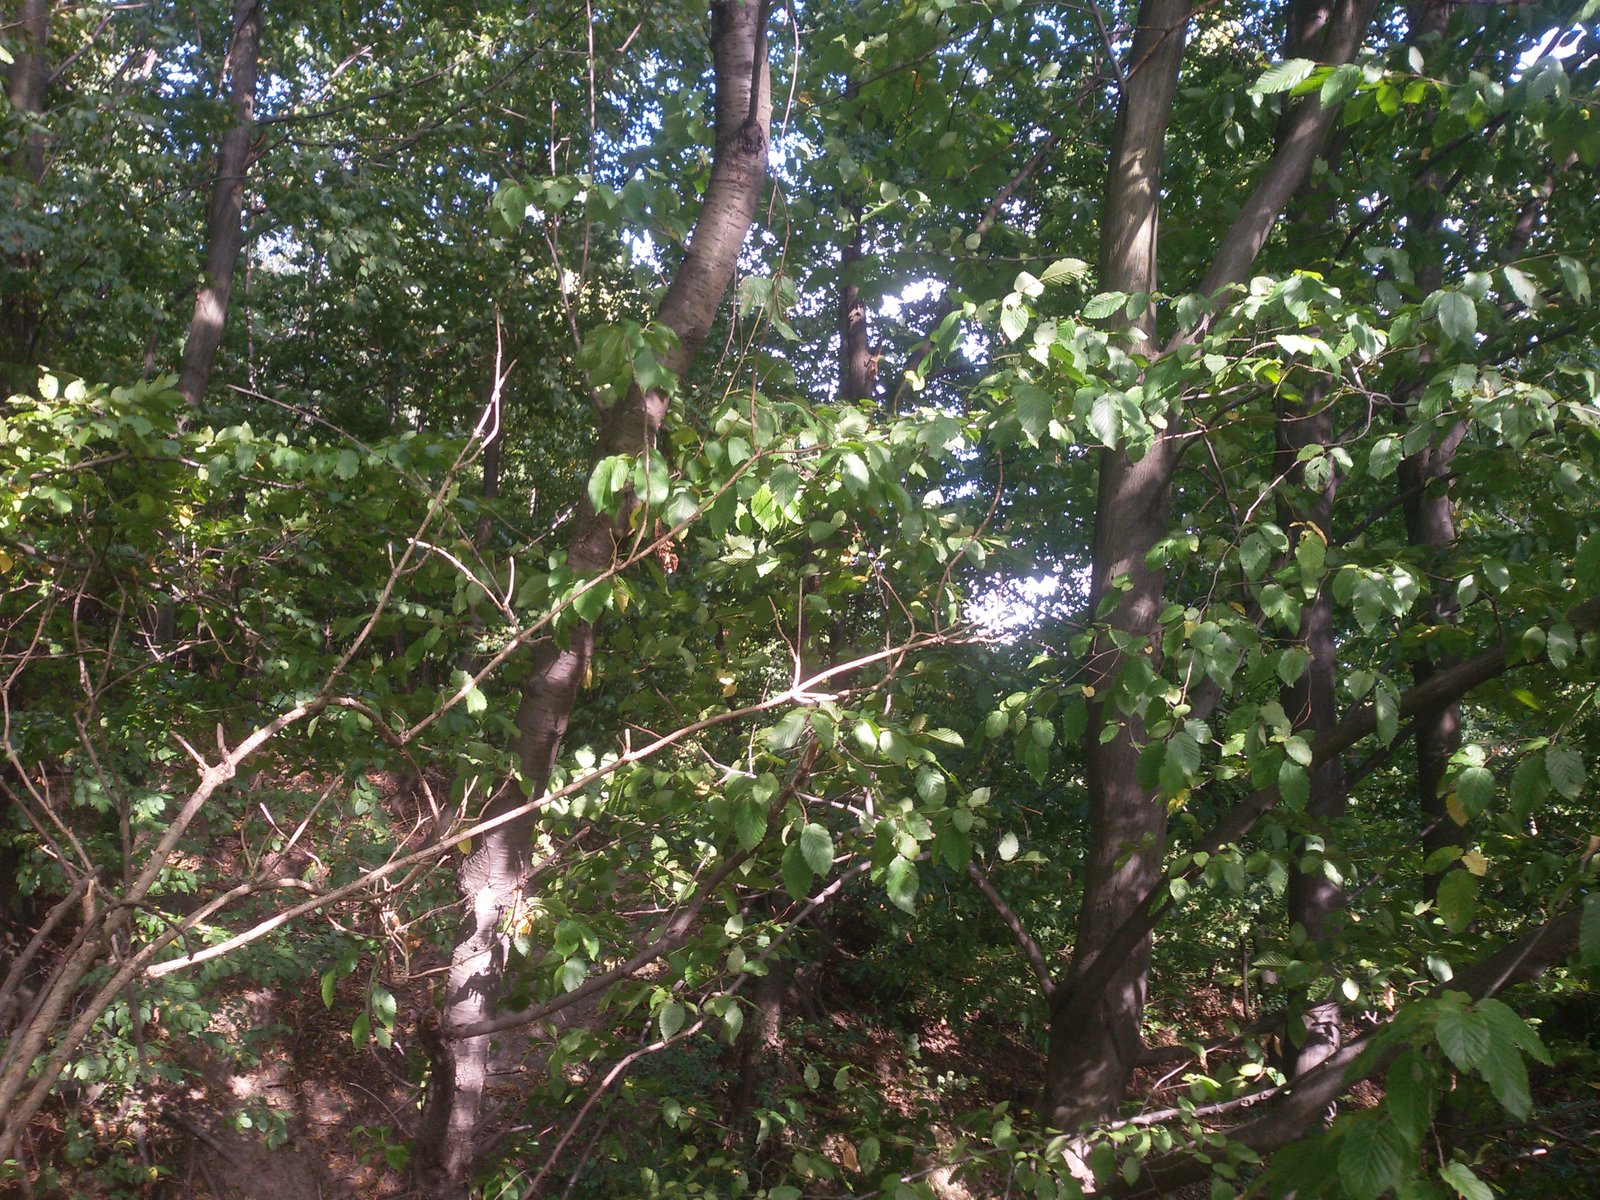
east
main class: Woodland
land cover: Broadleaved woodland
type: mesophytic deciduous forest
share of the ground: > 75 %
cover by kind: broadleaved forest trees 85 %, unconsolidated bare surface 10 %, herbaceous plants 5 %
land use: Forestry
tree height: > 5 m
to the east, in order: Broadleaved woodland; Spontaneously vegetated surfaces; Broadleaved woodland; Rye; Broadleaved woodland; Paved roads, cycling and walking lanes; Spontaneously vegetated surfaces; Electric lines; Potatoes; Broadleaved woodland; Tracks; Grassland with sparse tree/shrub cover
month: September
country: PL
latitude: 49.8314
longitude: 21.5479
